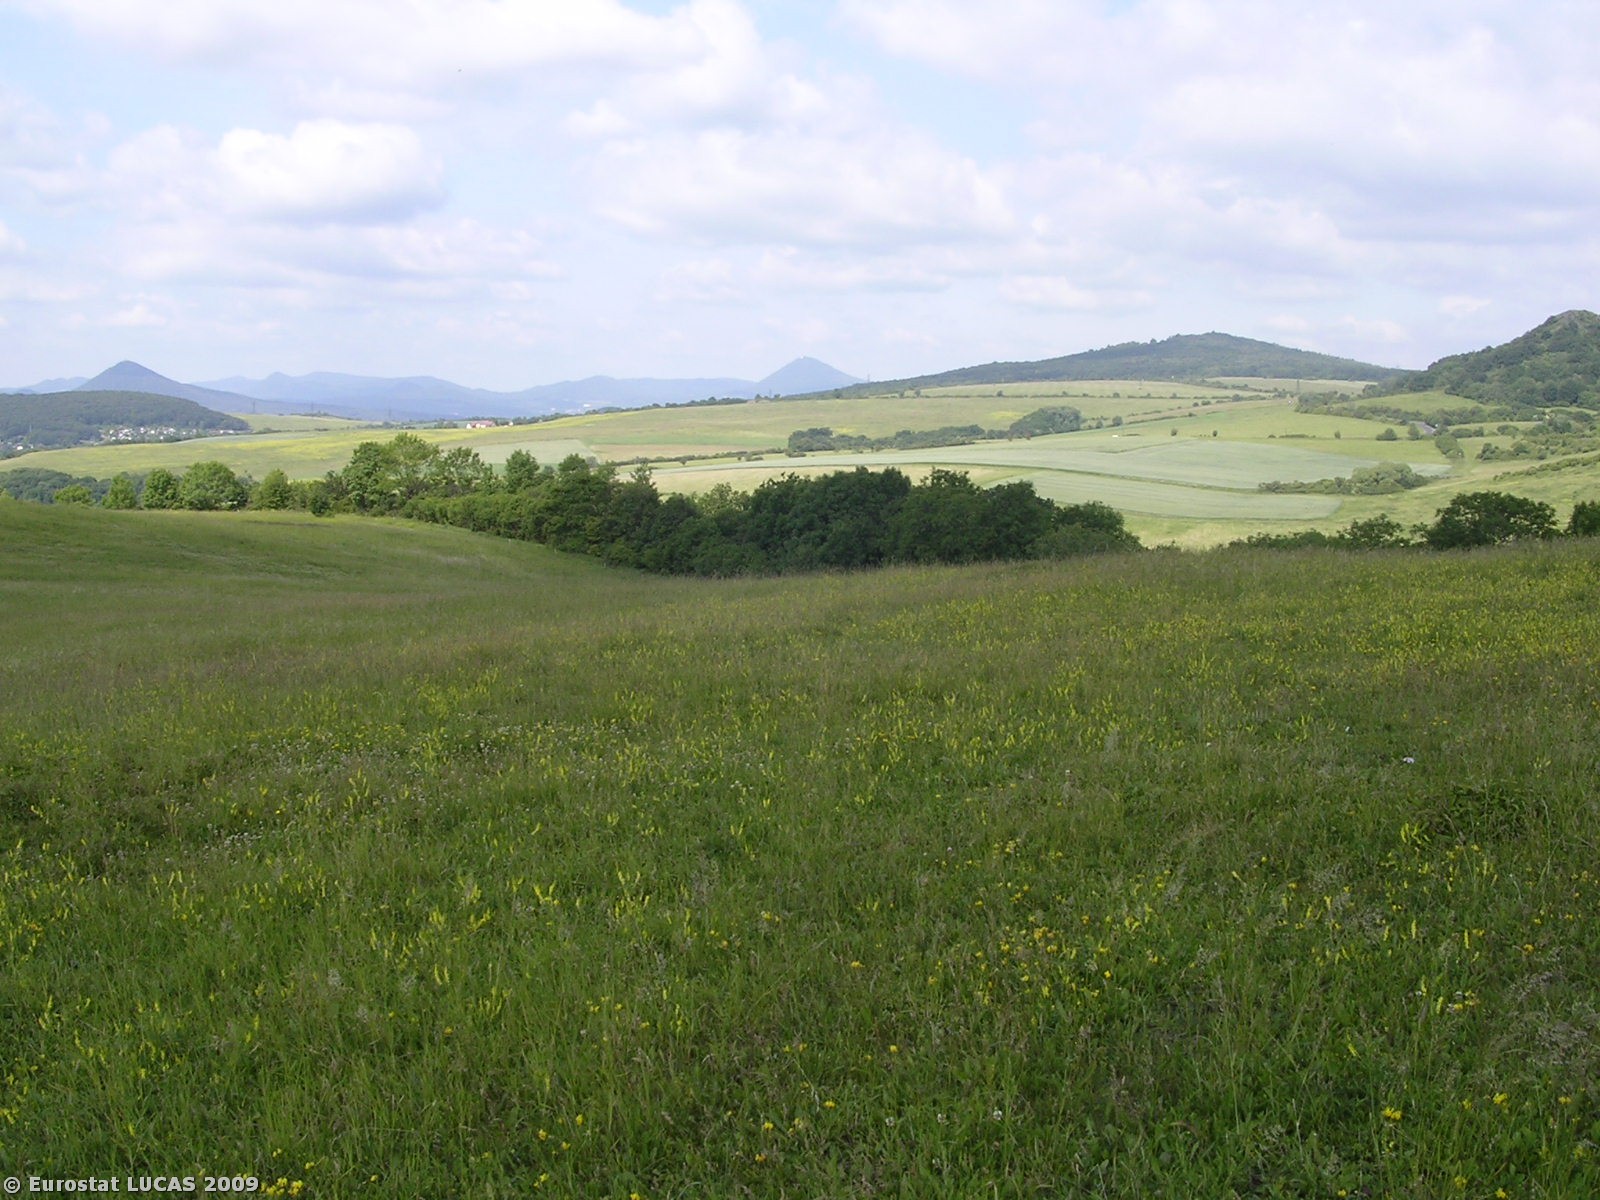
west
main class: Grassland
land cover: Grassland without tree/shrub cover
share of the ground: > 75 %
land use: Agriculture (excluding fallow land and kitchen gardens)
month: June
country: CZ
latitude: 50.5593
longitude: 14.1372
